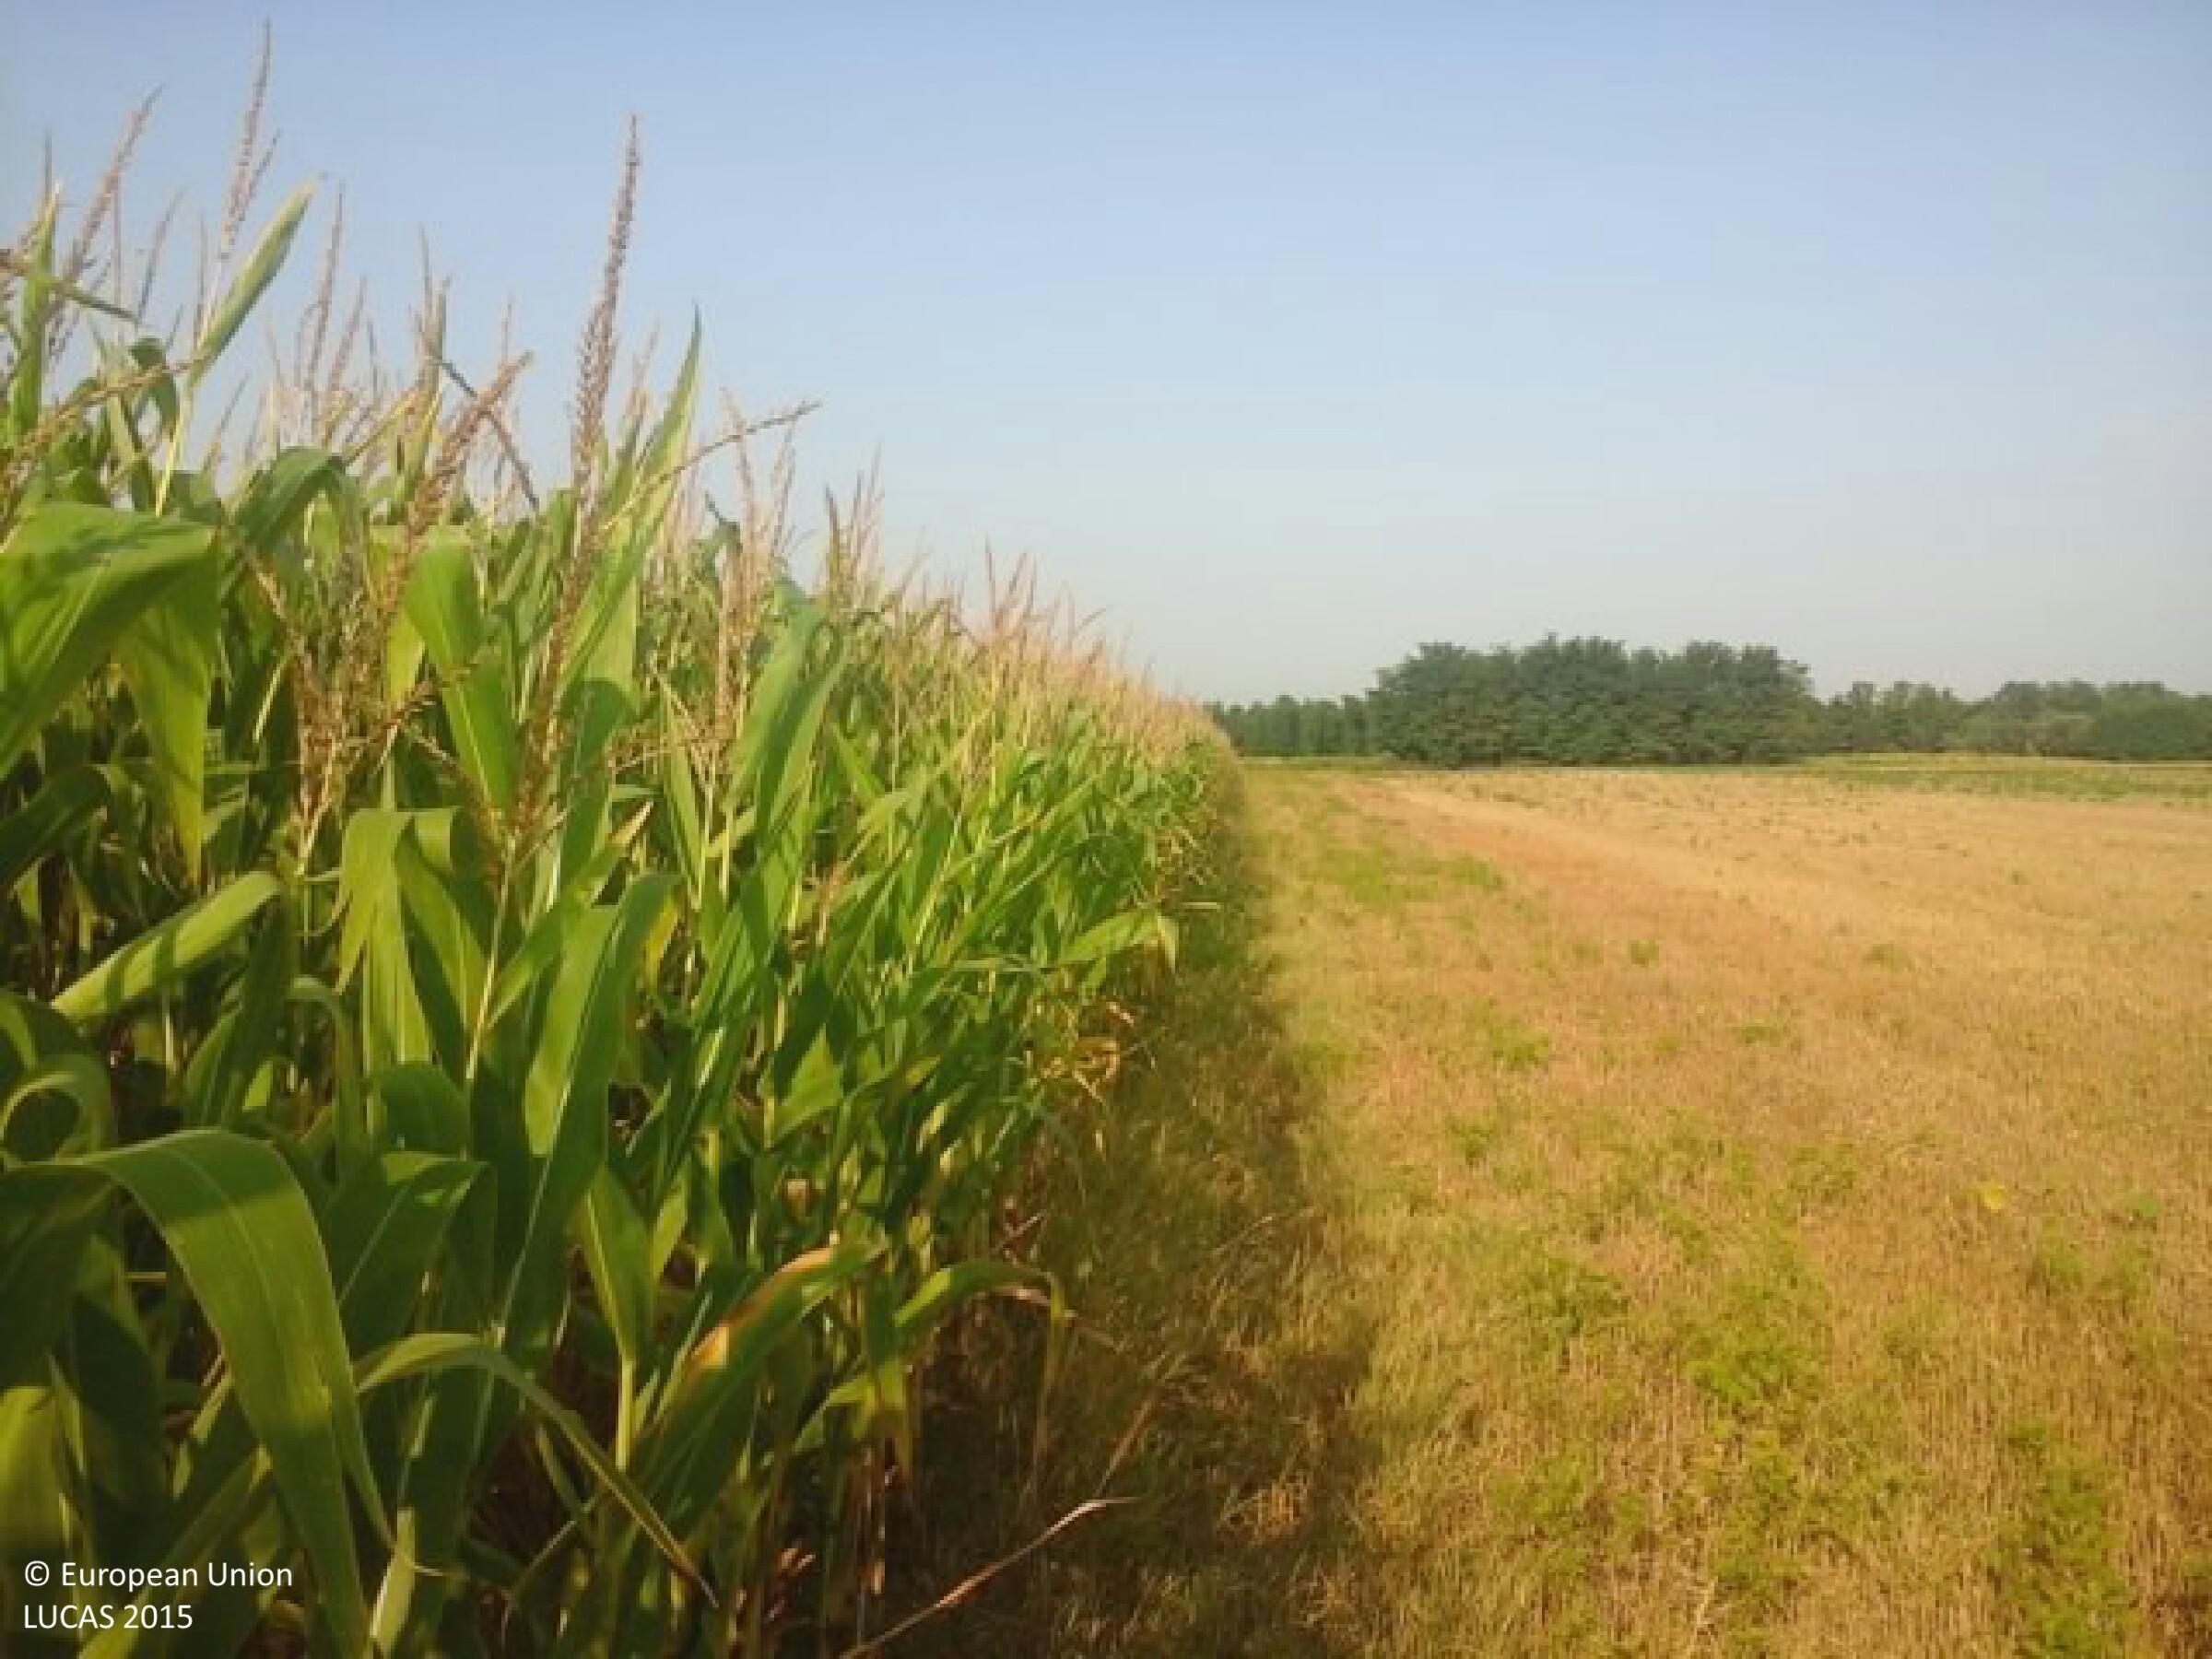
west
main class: Cropland
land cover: Maize
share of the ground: > 75 %
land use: Agriculture (excluding fallow land and kitchen gardens)
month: August
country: HU
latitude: 46.3908
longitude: 18.0570
